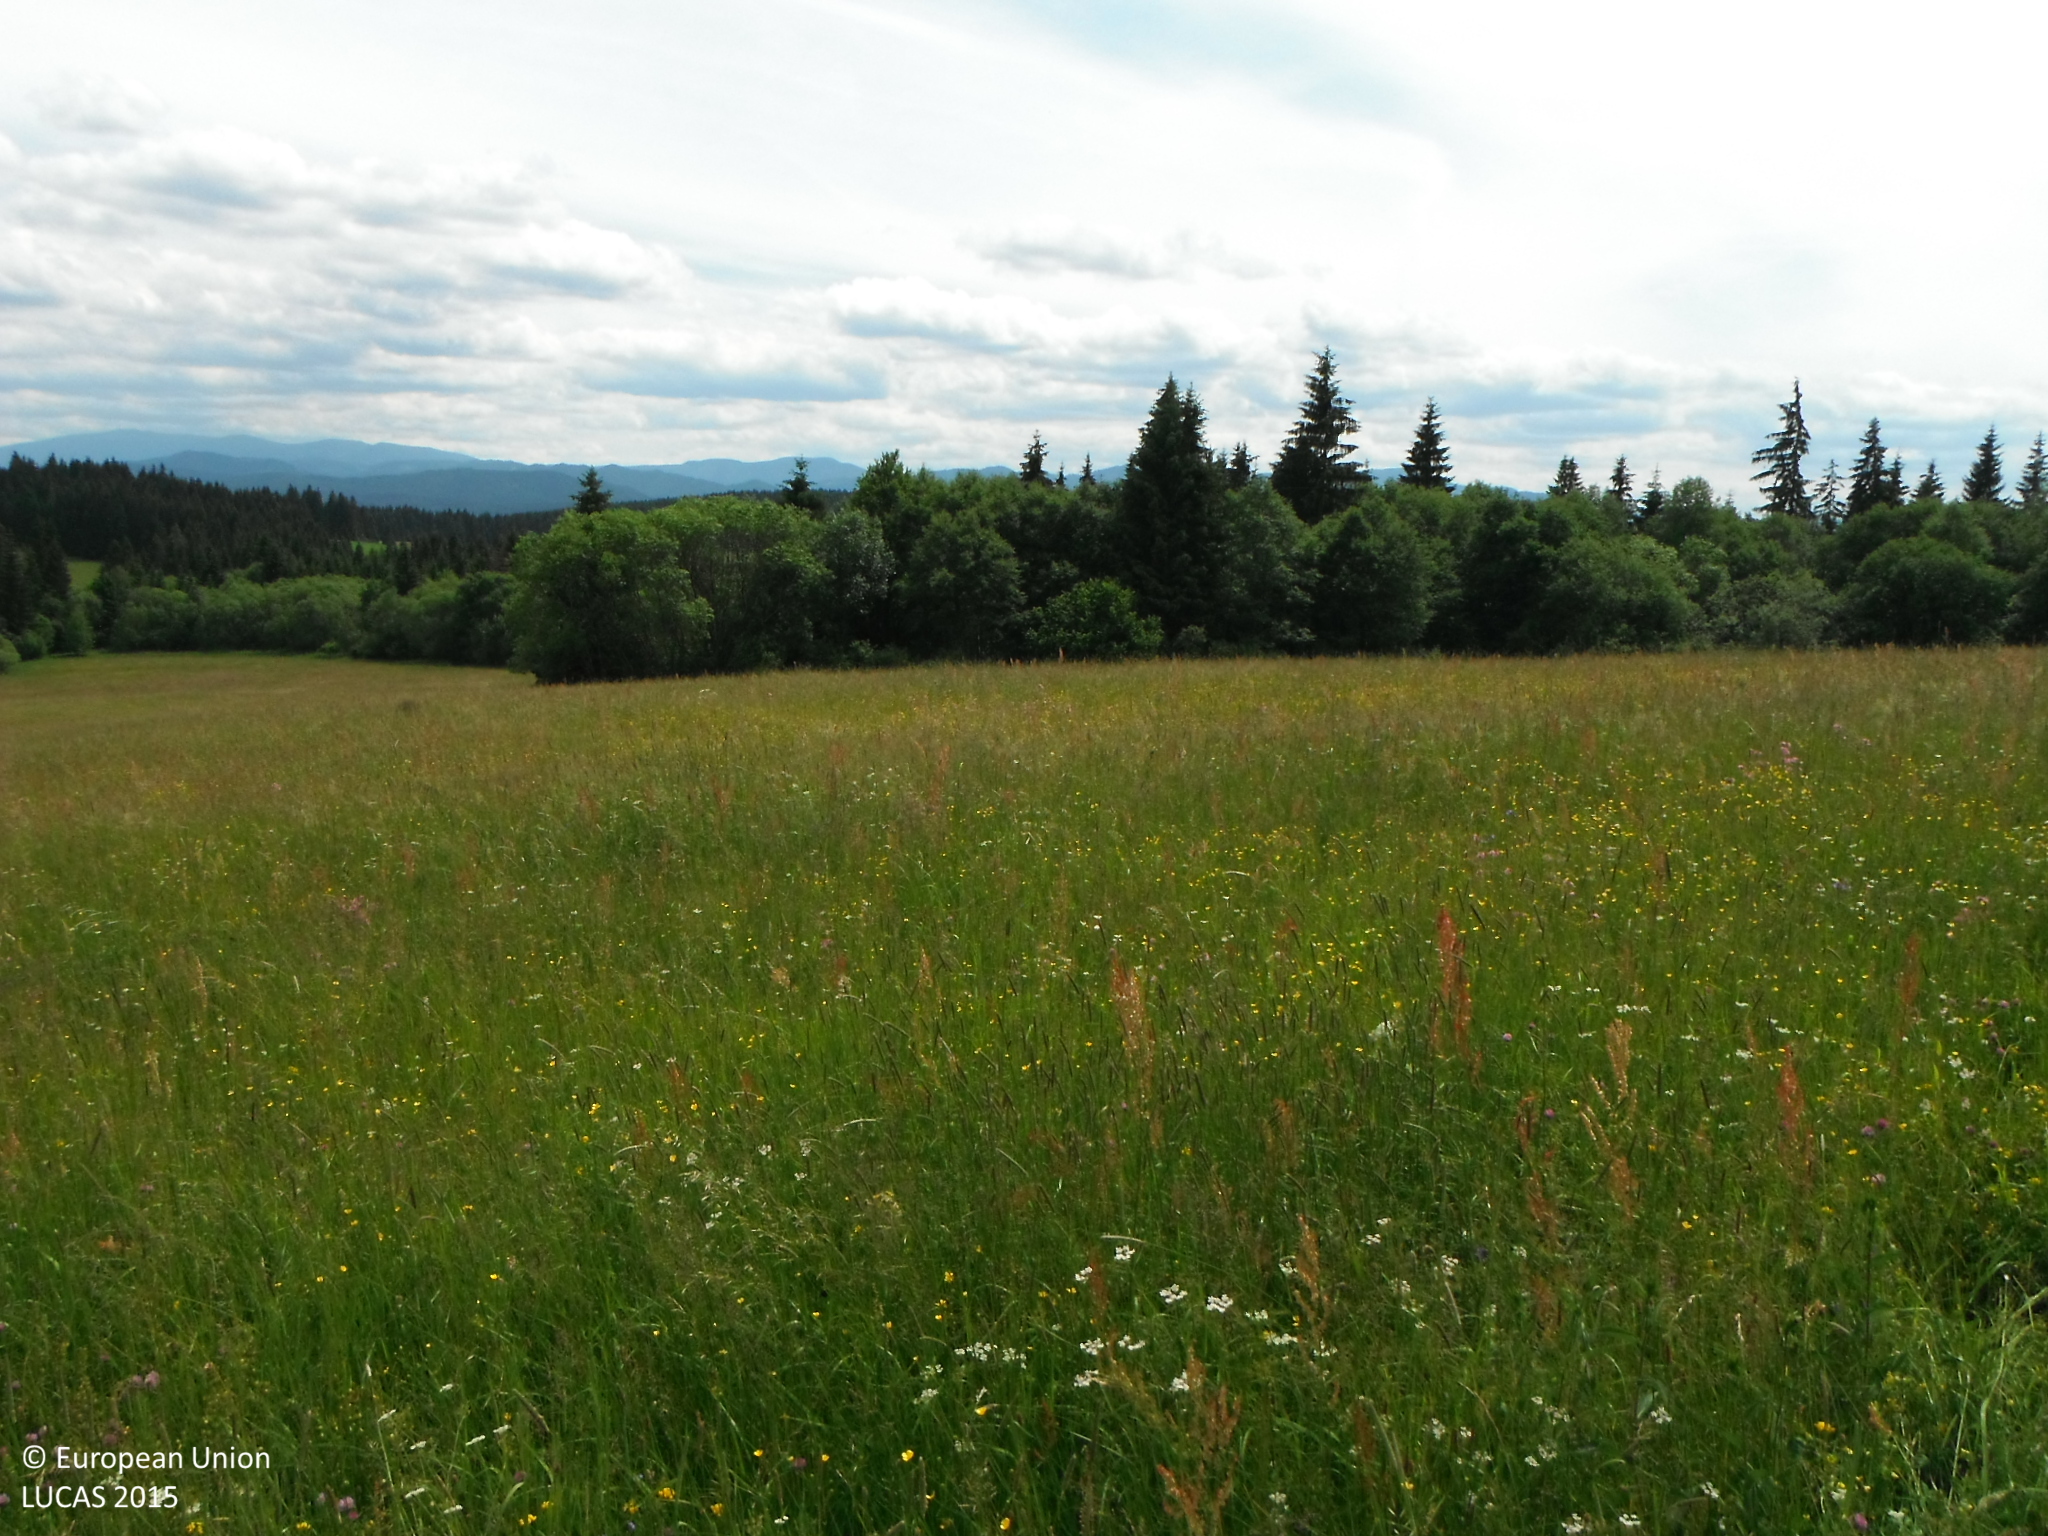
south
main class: Grassland
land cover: Grassland without tree/shrub cover
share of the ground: > 75 %
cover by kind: herbaceous plants 100 %
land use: Agriculture (excluding fallow land and kitchen gardens)
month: June
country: SK
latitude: 49.1149
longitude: 19.9357
